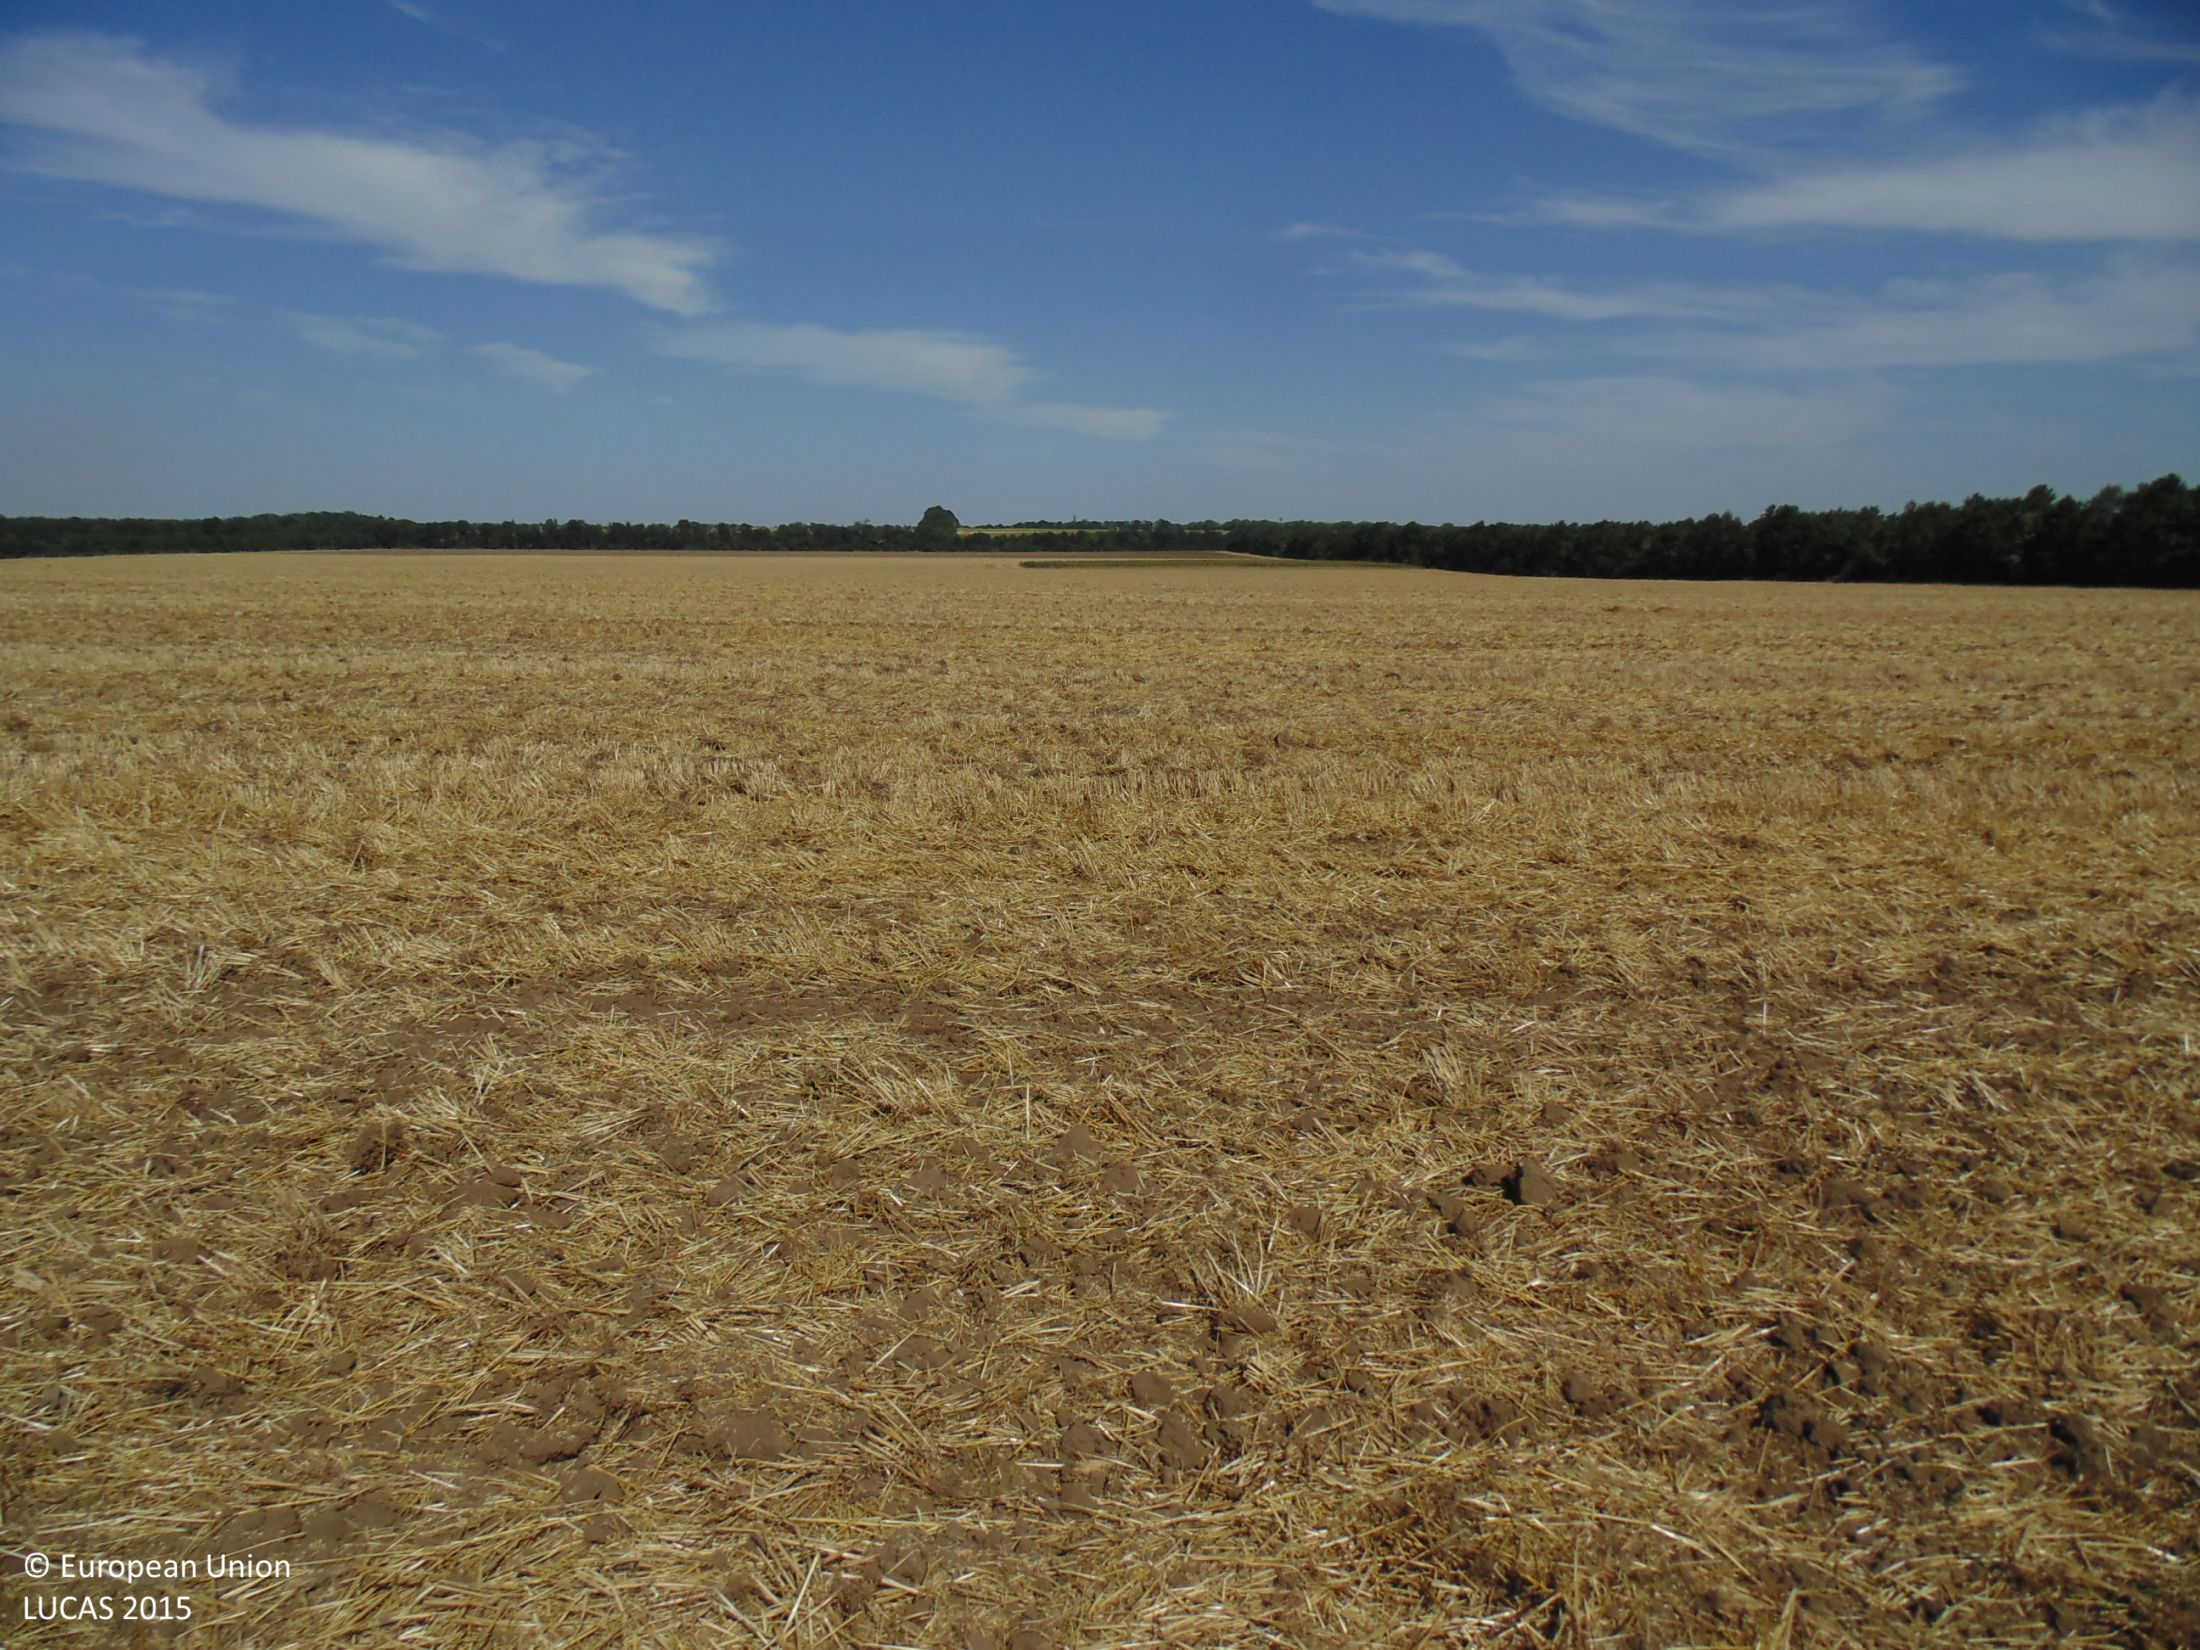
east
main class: Cropland
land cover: Common wheat
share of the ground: < 10 %
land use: Agriculture (excluding fallow land and kitchen gardens)
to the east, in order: Common wheat
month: August
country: BG
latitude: 43.8084
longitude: 27.7057
